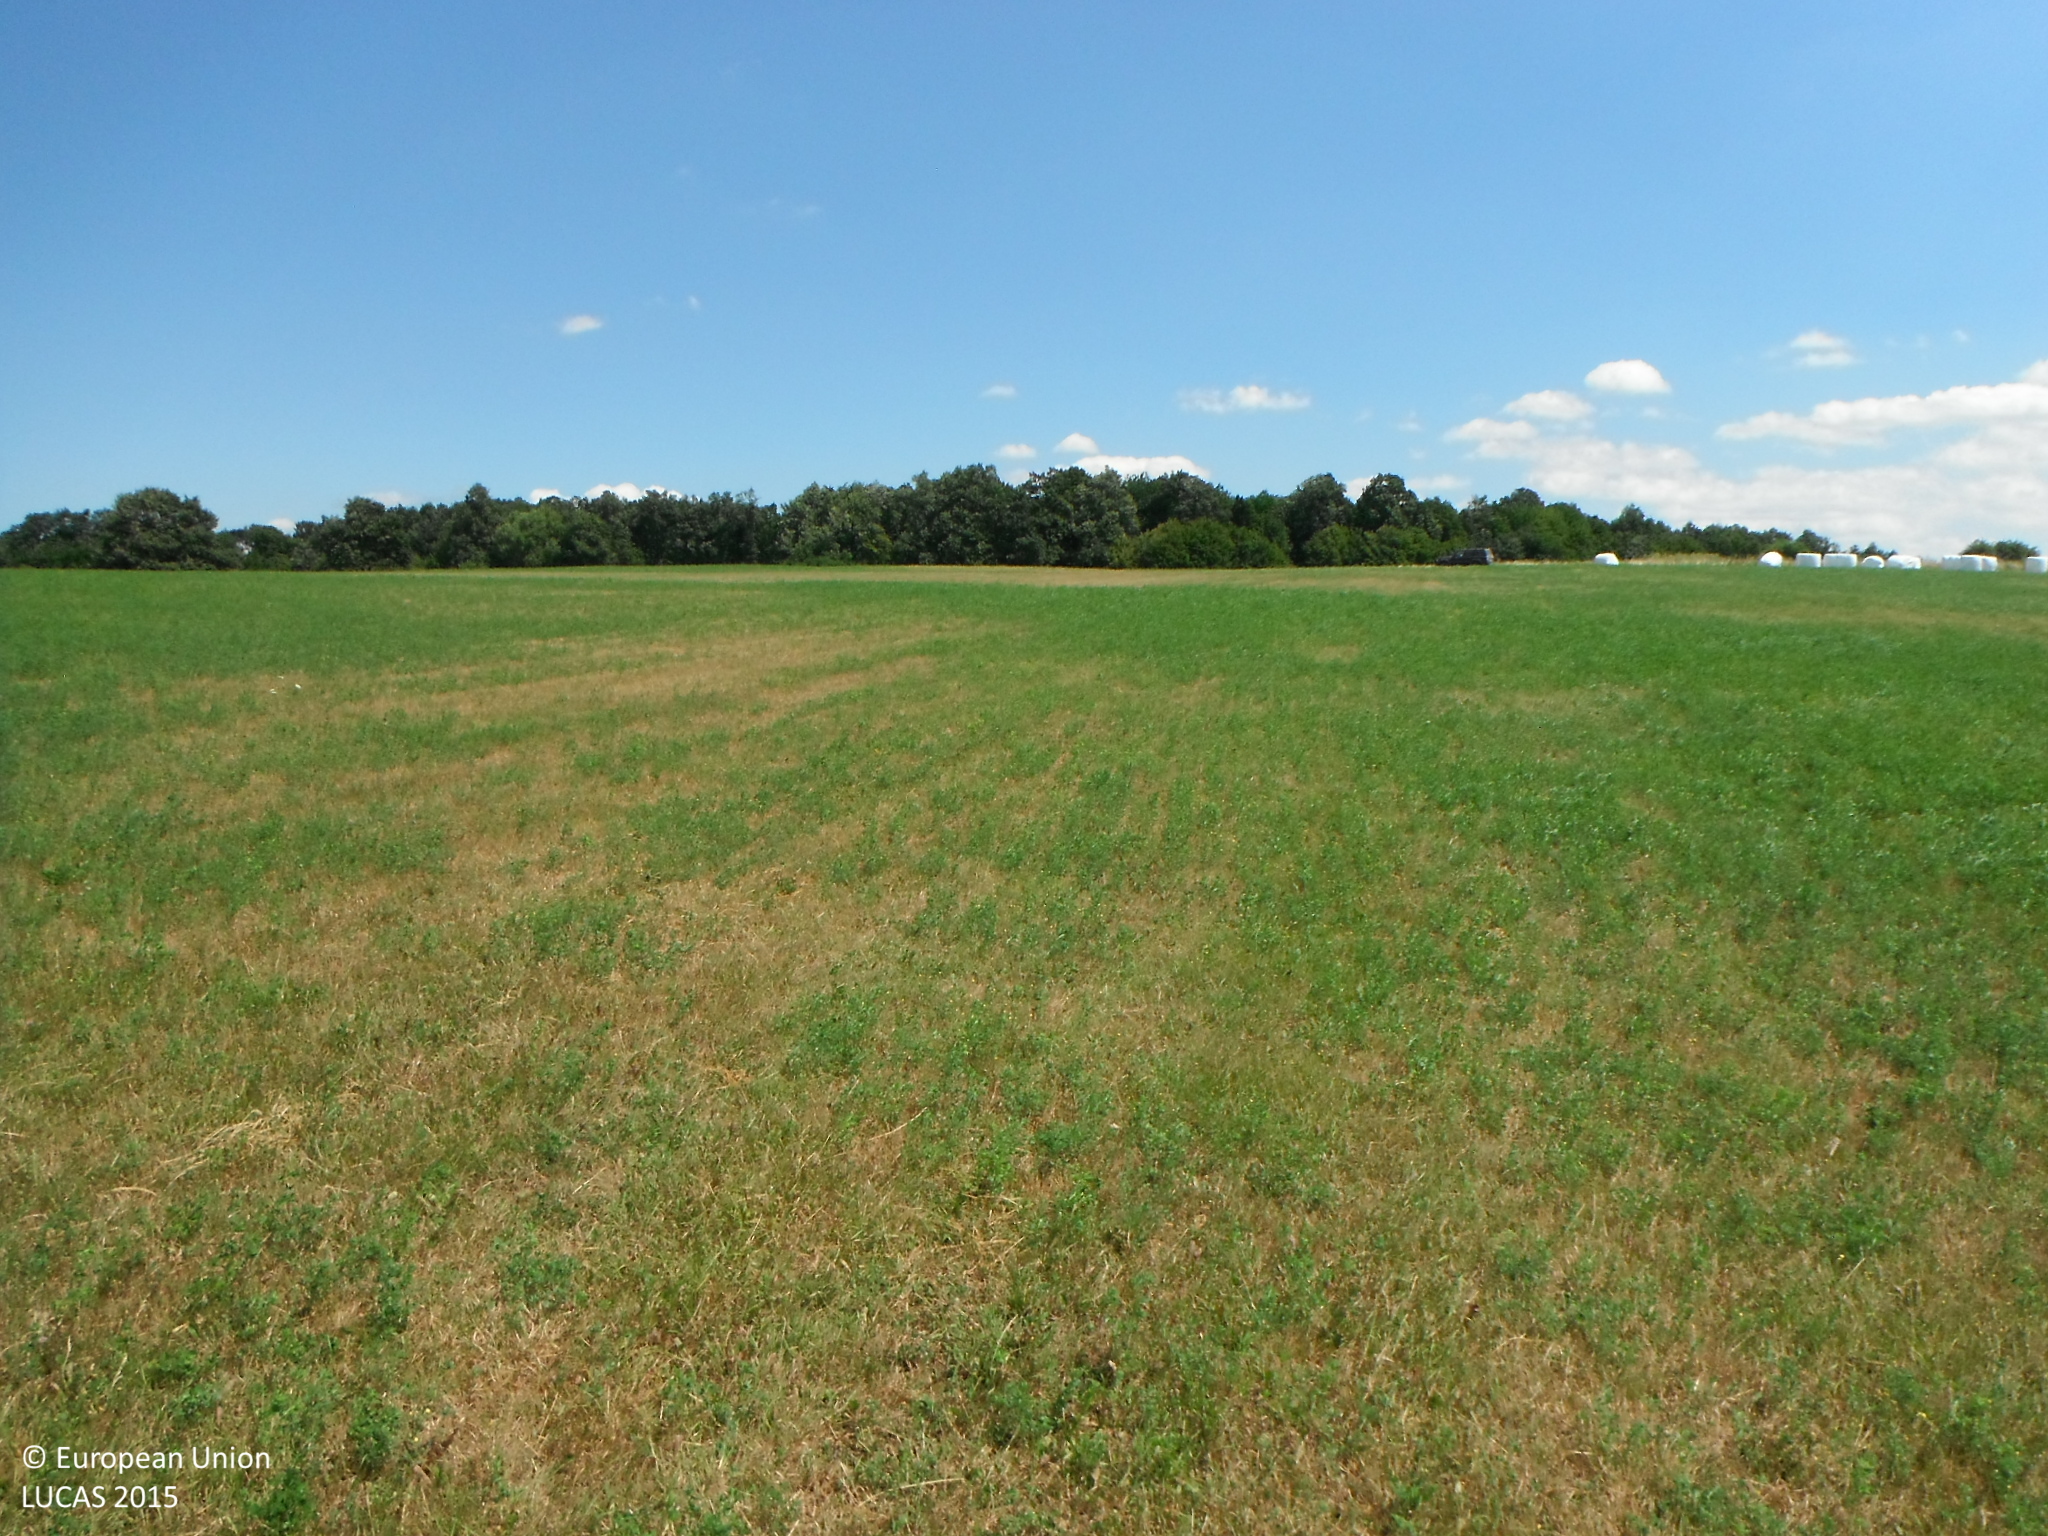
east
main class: Cropland
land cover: Other leguminous and mixtures for fodder
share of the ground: > 75 %
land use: Agriculture (excluding fallow land and kitchen gardens)
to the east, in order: Other leguminous and mixtures for fodder; Grassland without tree/shrub cover; Other leguminous and mixtures for fodder
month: July
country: SK
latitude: 48.2529
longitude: 19.2207
